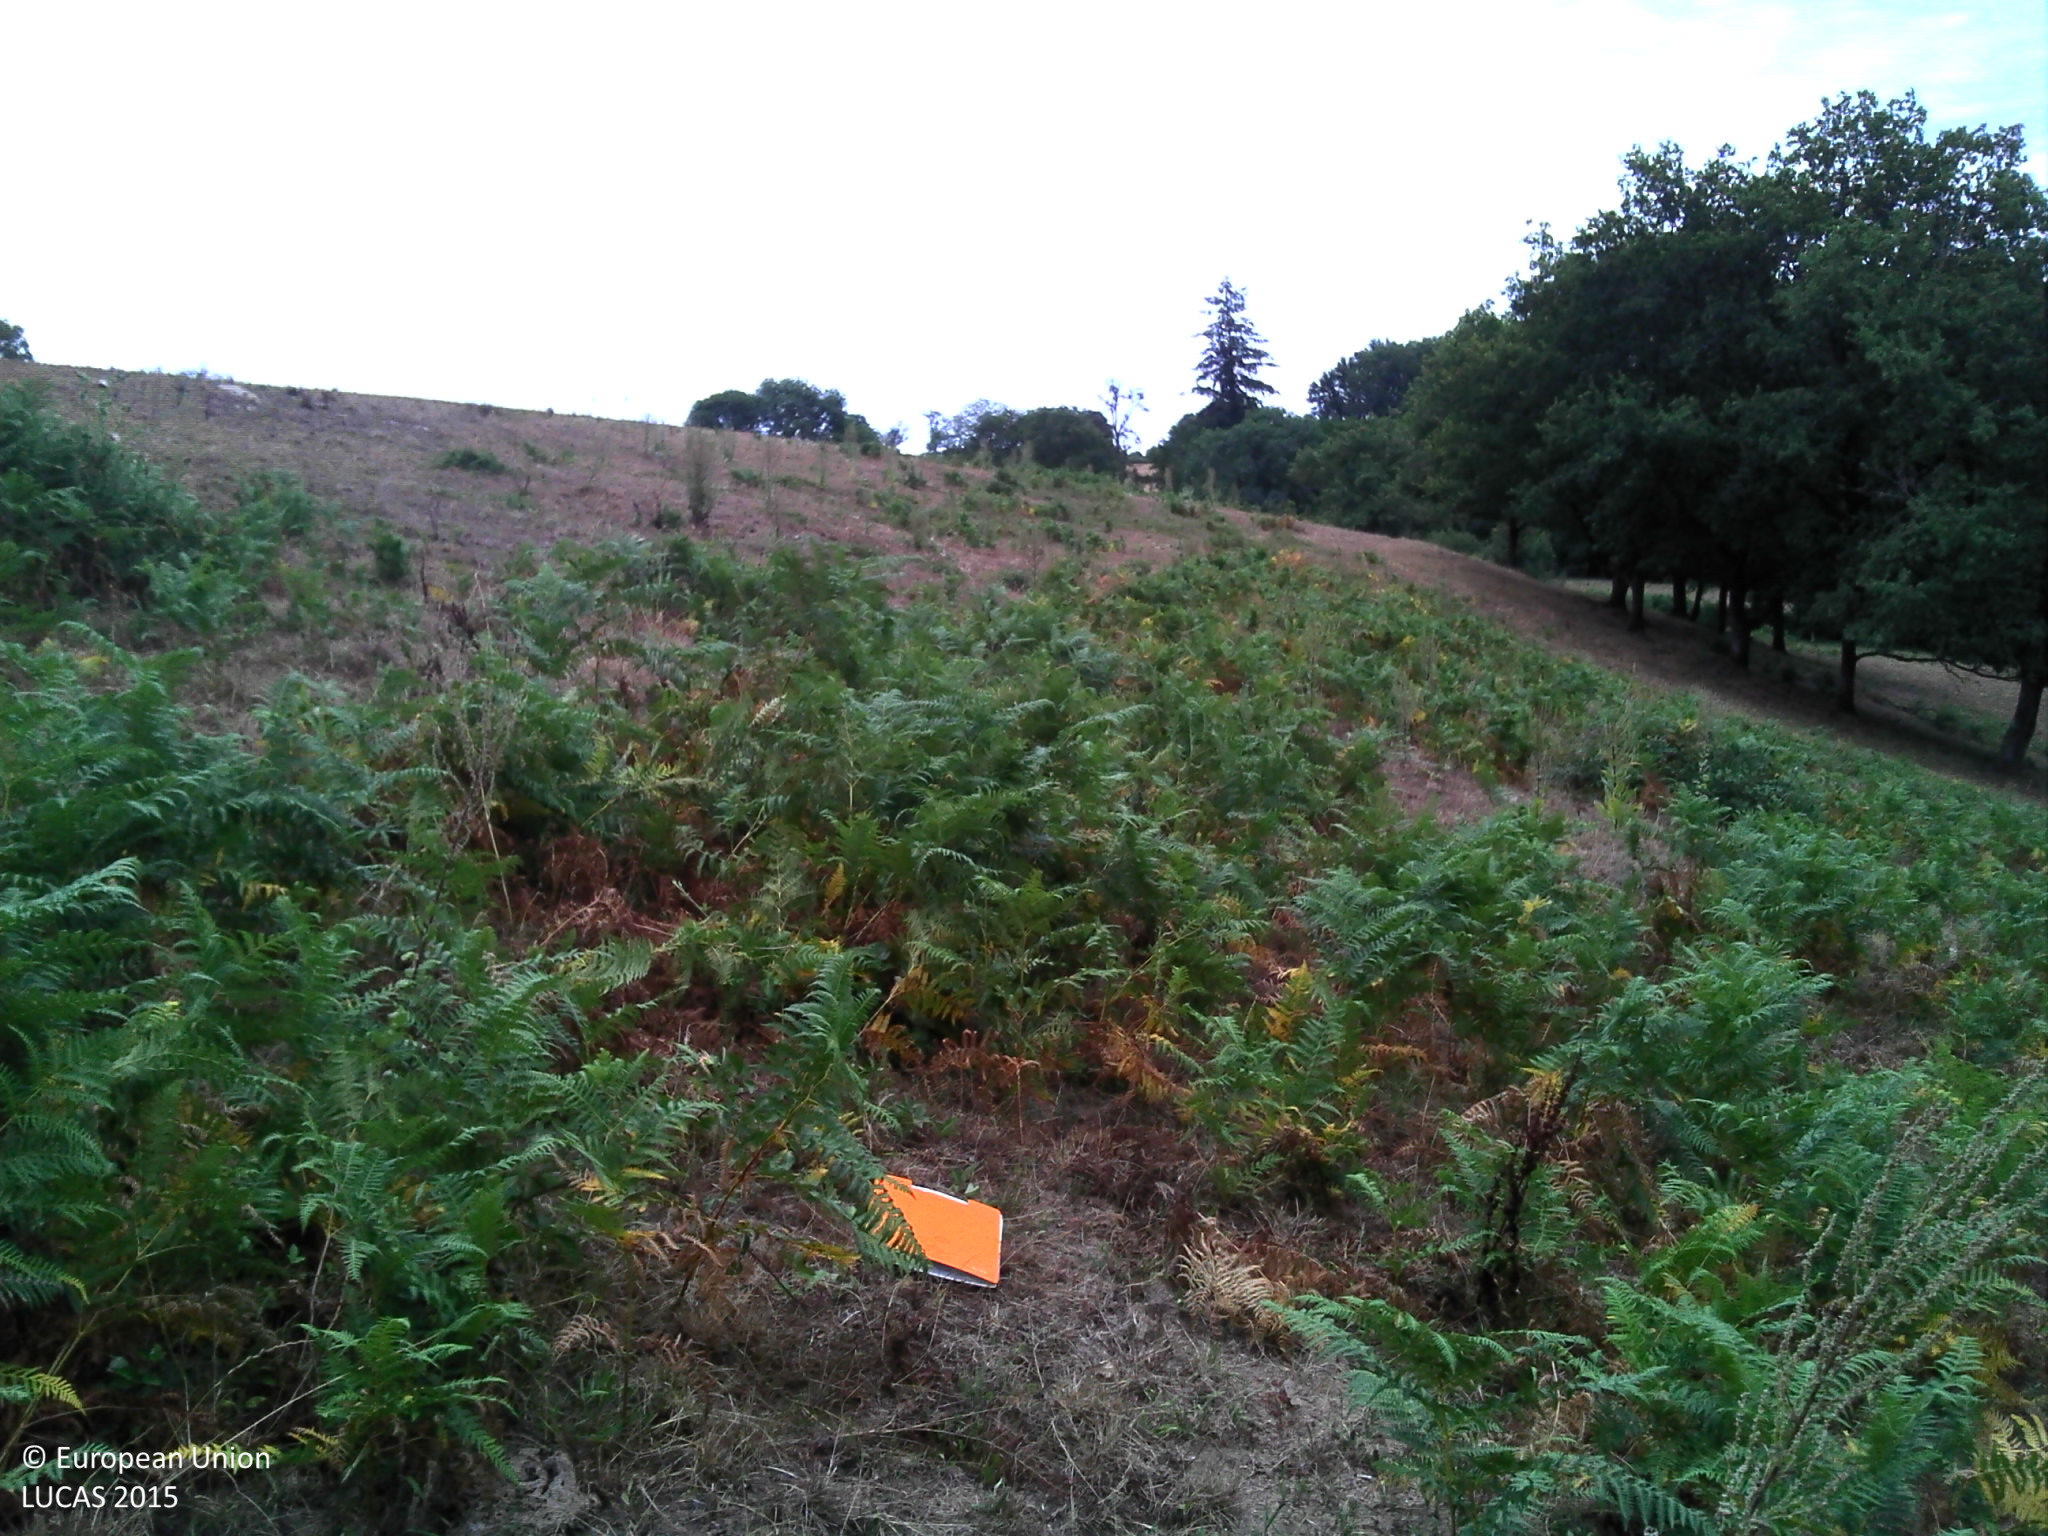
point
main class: Grassland
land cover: Grassland without tree/shrub cover
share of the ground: > 75 %
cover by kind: herbaceous plants 95 %, shrubs 5 %
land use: Agriculture (excluding fallow land and kitchen gardens)
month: July
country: FR
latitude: 46.5448
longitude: 2.8369
